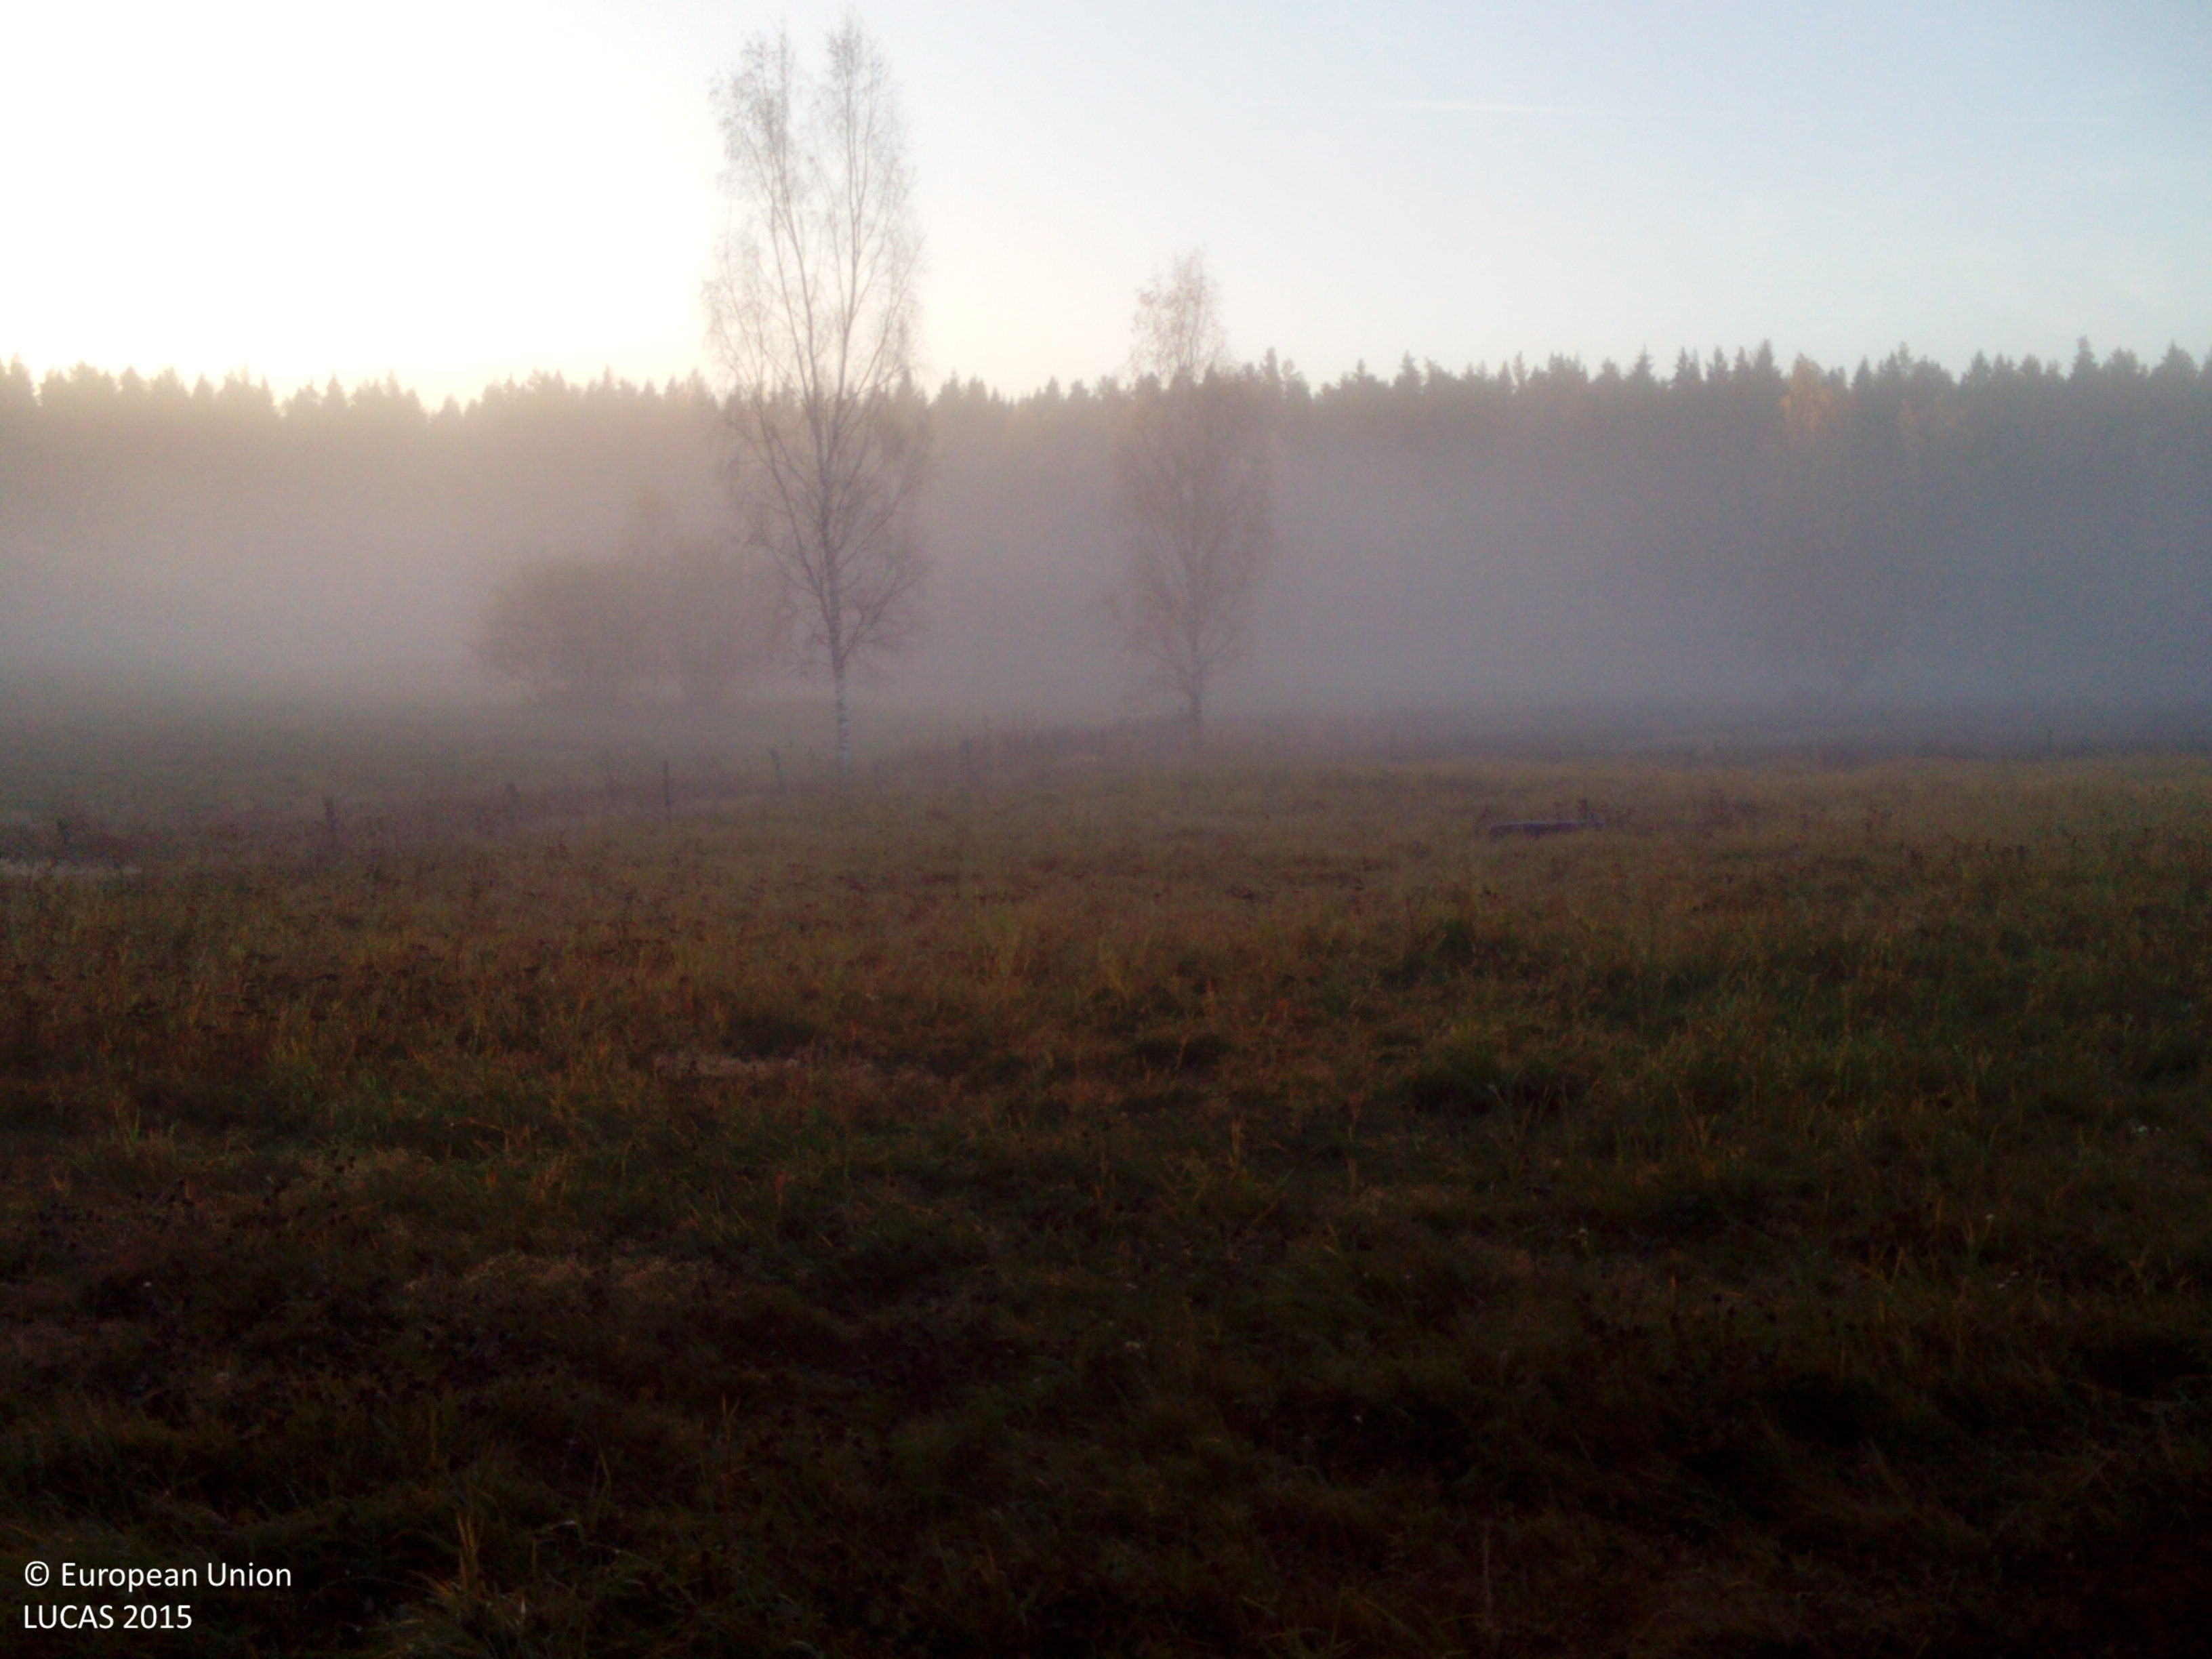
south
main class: Grassland
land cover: Grassland without tree/shrub cover
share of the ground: > 75 %
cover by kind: herbaceous plants 100 %
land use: Agriculture (excluding fallow land and kitchen gardens)
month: October
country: SE
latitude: 59.0945
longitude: 16.4349
